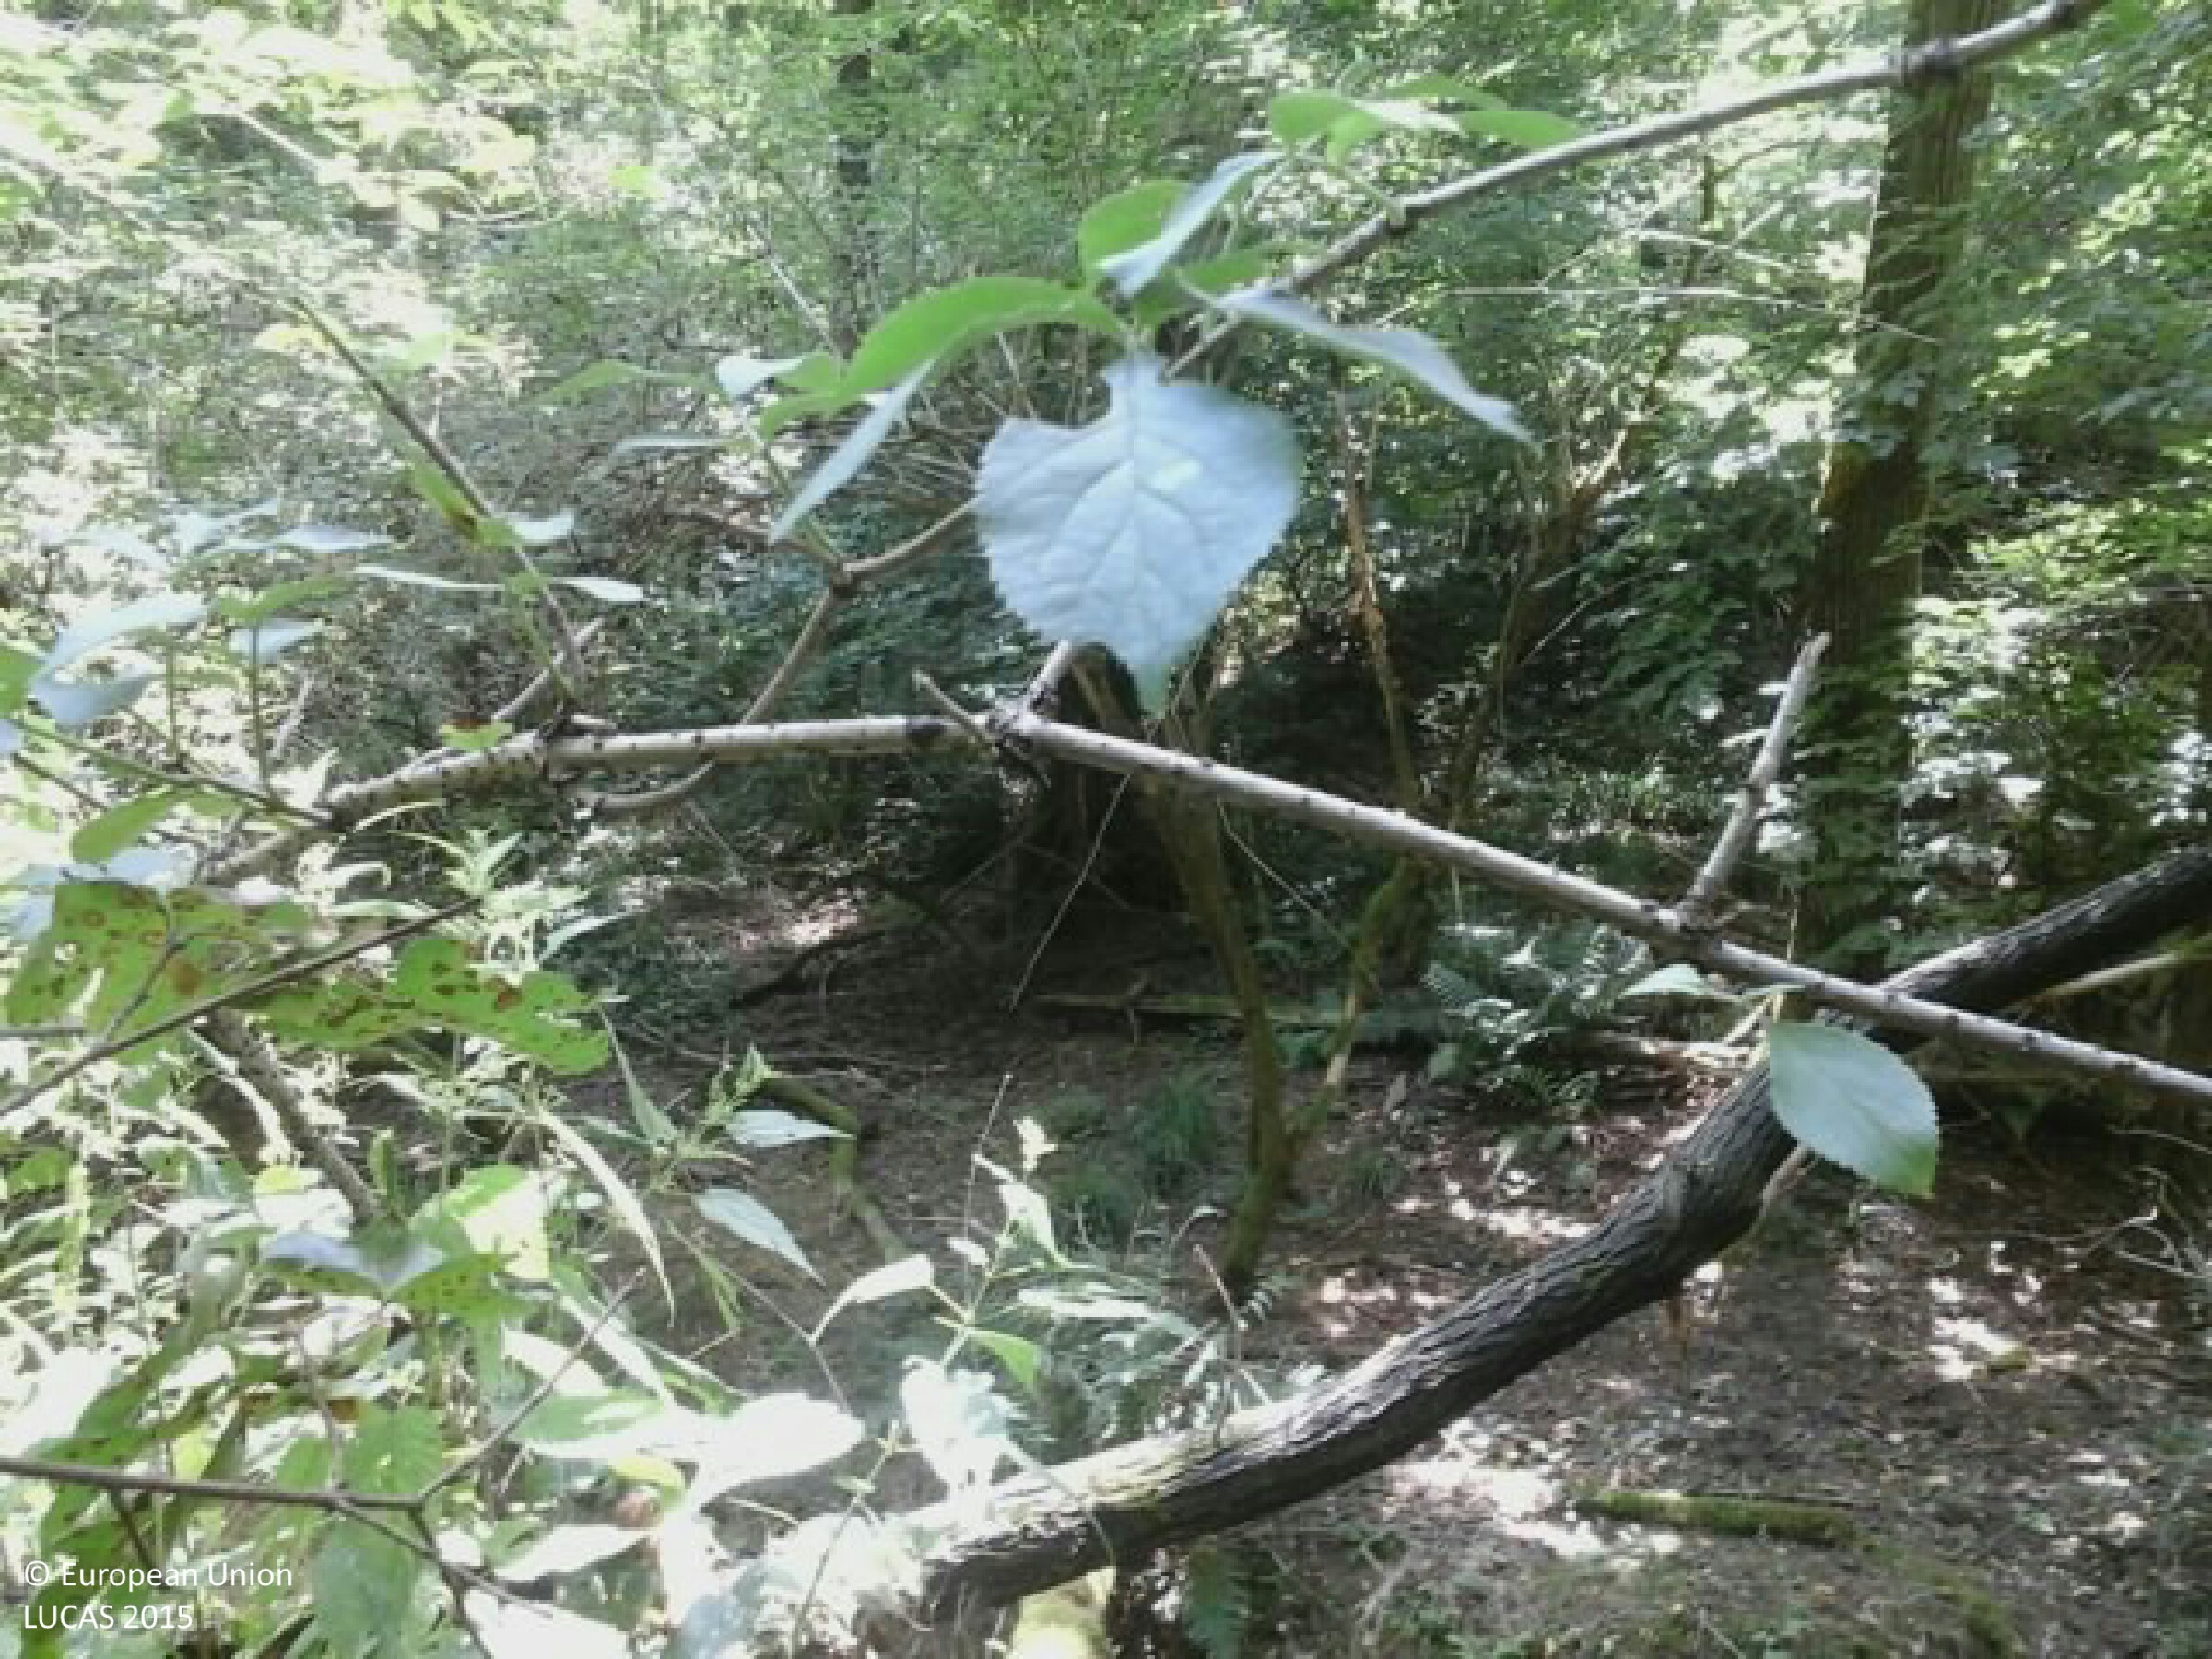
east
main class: Woodland
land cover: Broadleaved woodland
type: mesophytic deciduous forest
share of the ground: > 75 %
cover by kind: broadleaved forest trees 90 %, shrubs 5 %, herbaceous plants 5 %
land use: Forestry
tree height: > 5 m
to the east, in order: Broadleaved woodland
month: July
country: HU
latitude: 46.3187
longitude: 17.0285
